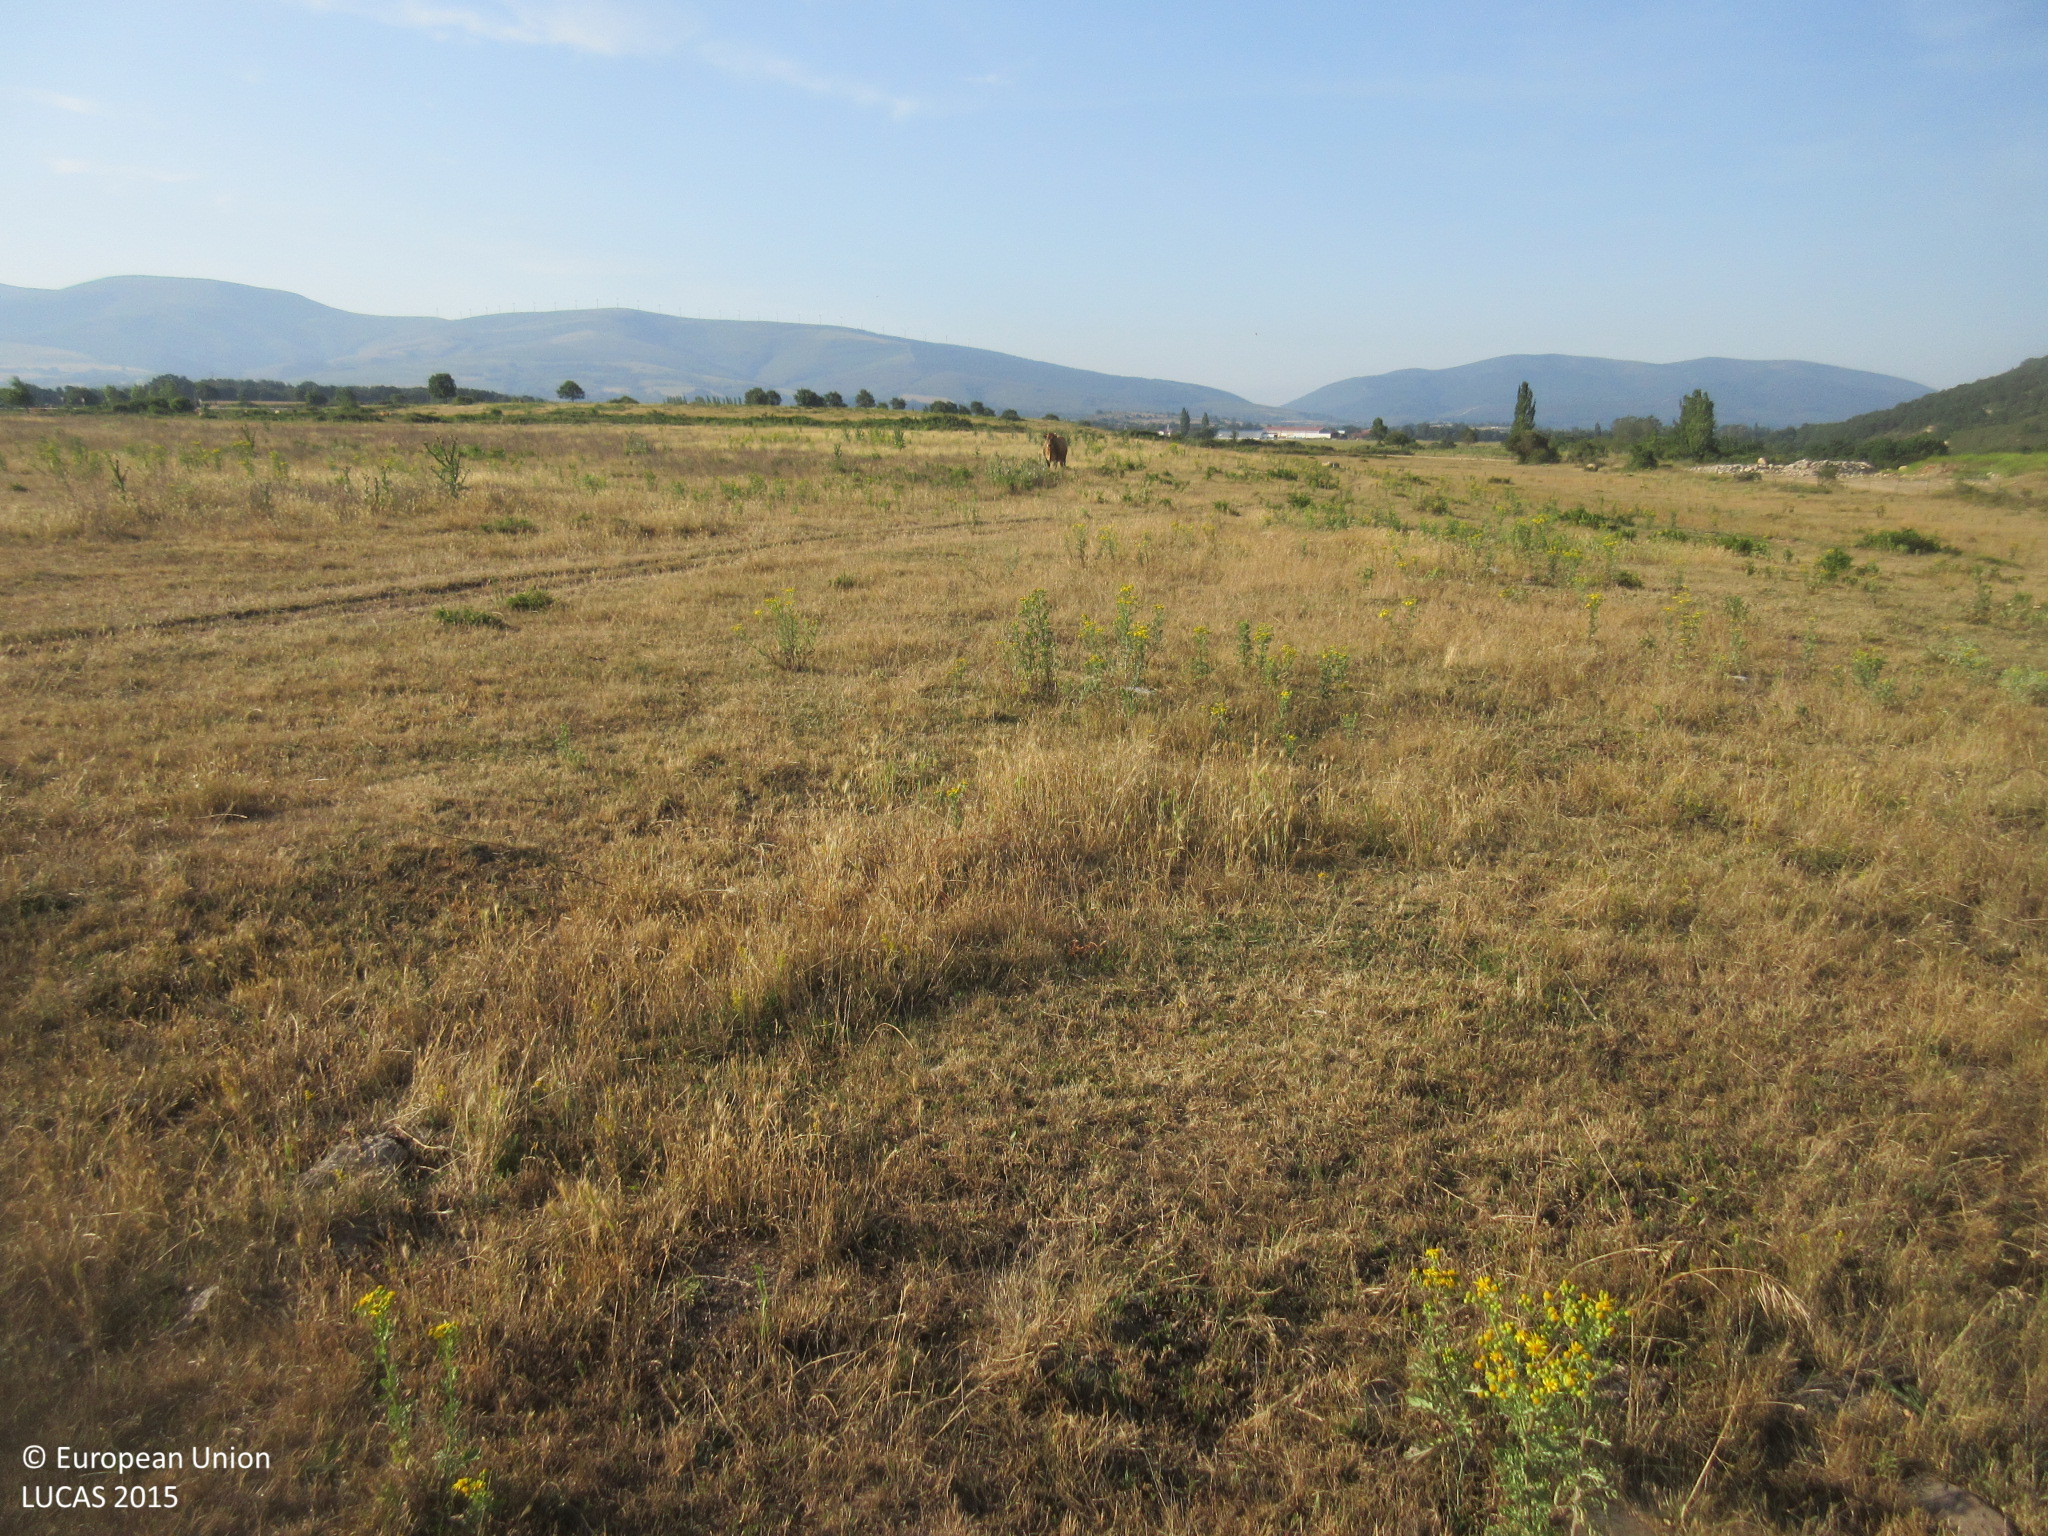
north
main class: Grassland
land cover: Grassland without tree/shrub cover
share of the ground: > 75 %
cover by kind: herbaceous plants 100 %
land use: Agriculture (excluding fallow land and kitchen gardens)
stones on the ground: < 10 %
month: July
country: ES
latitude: 43.0459
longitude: -3.4821
